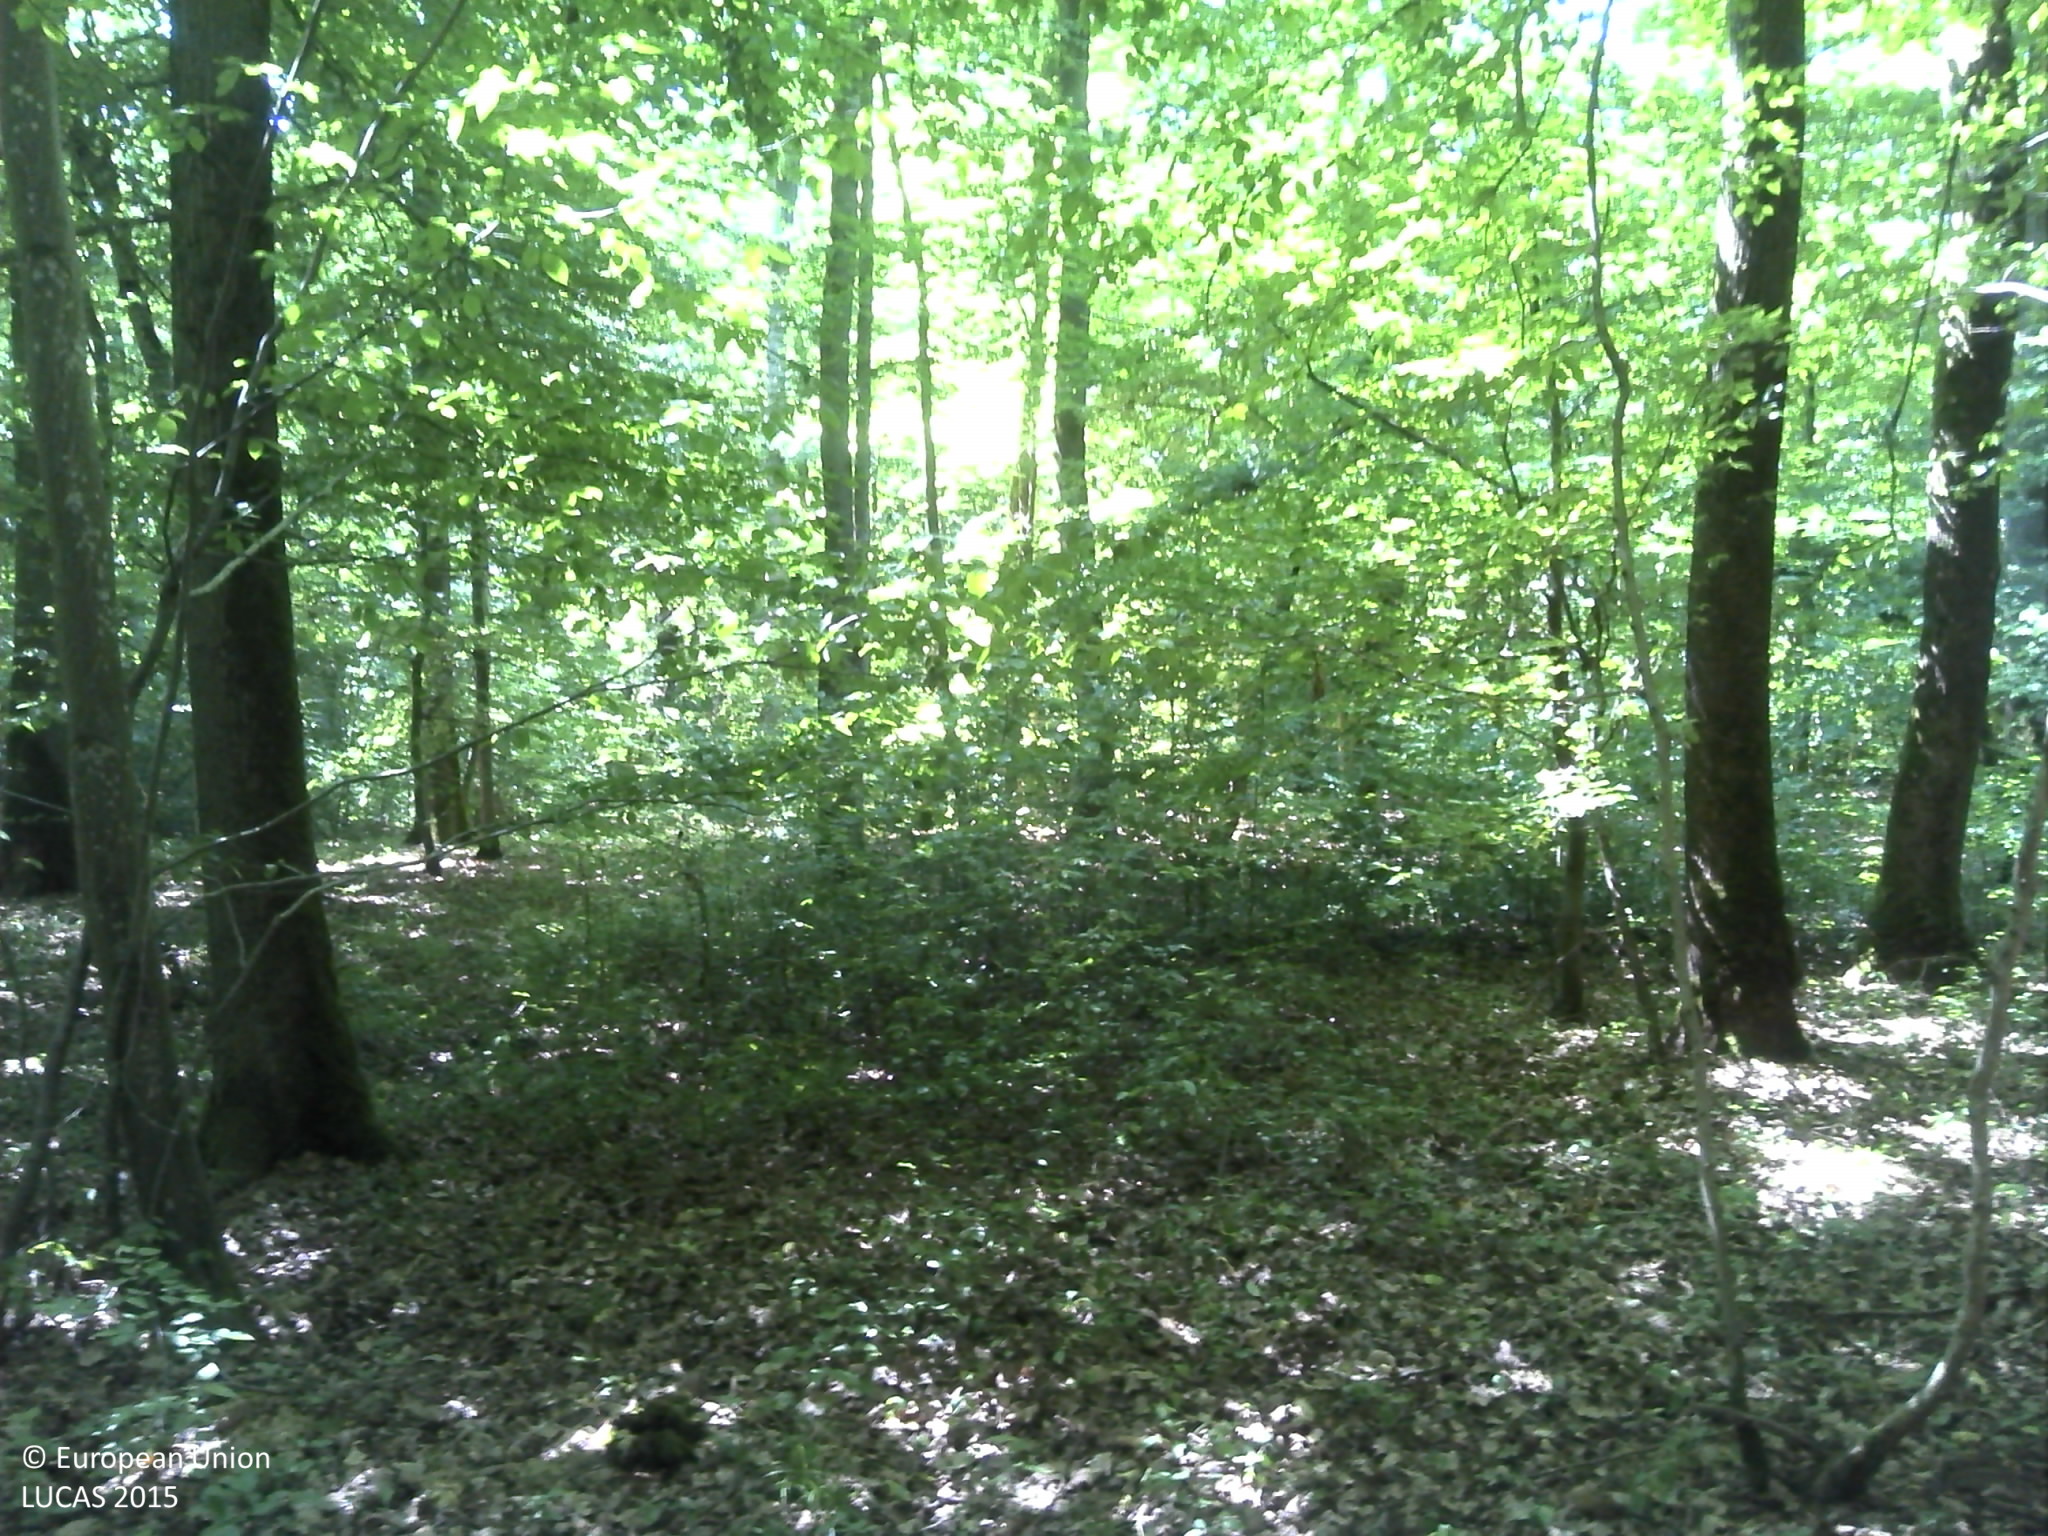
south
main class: Woodland
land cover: Broadleaved woodland
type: mesophytic deciduous forest
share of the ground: > 75 %
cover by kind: broadleaved forest trees 100 %
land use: Forestry
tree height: > 5 m
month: July
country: FR
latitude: 49.4711
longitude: 6.1494
